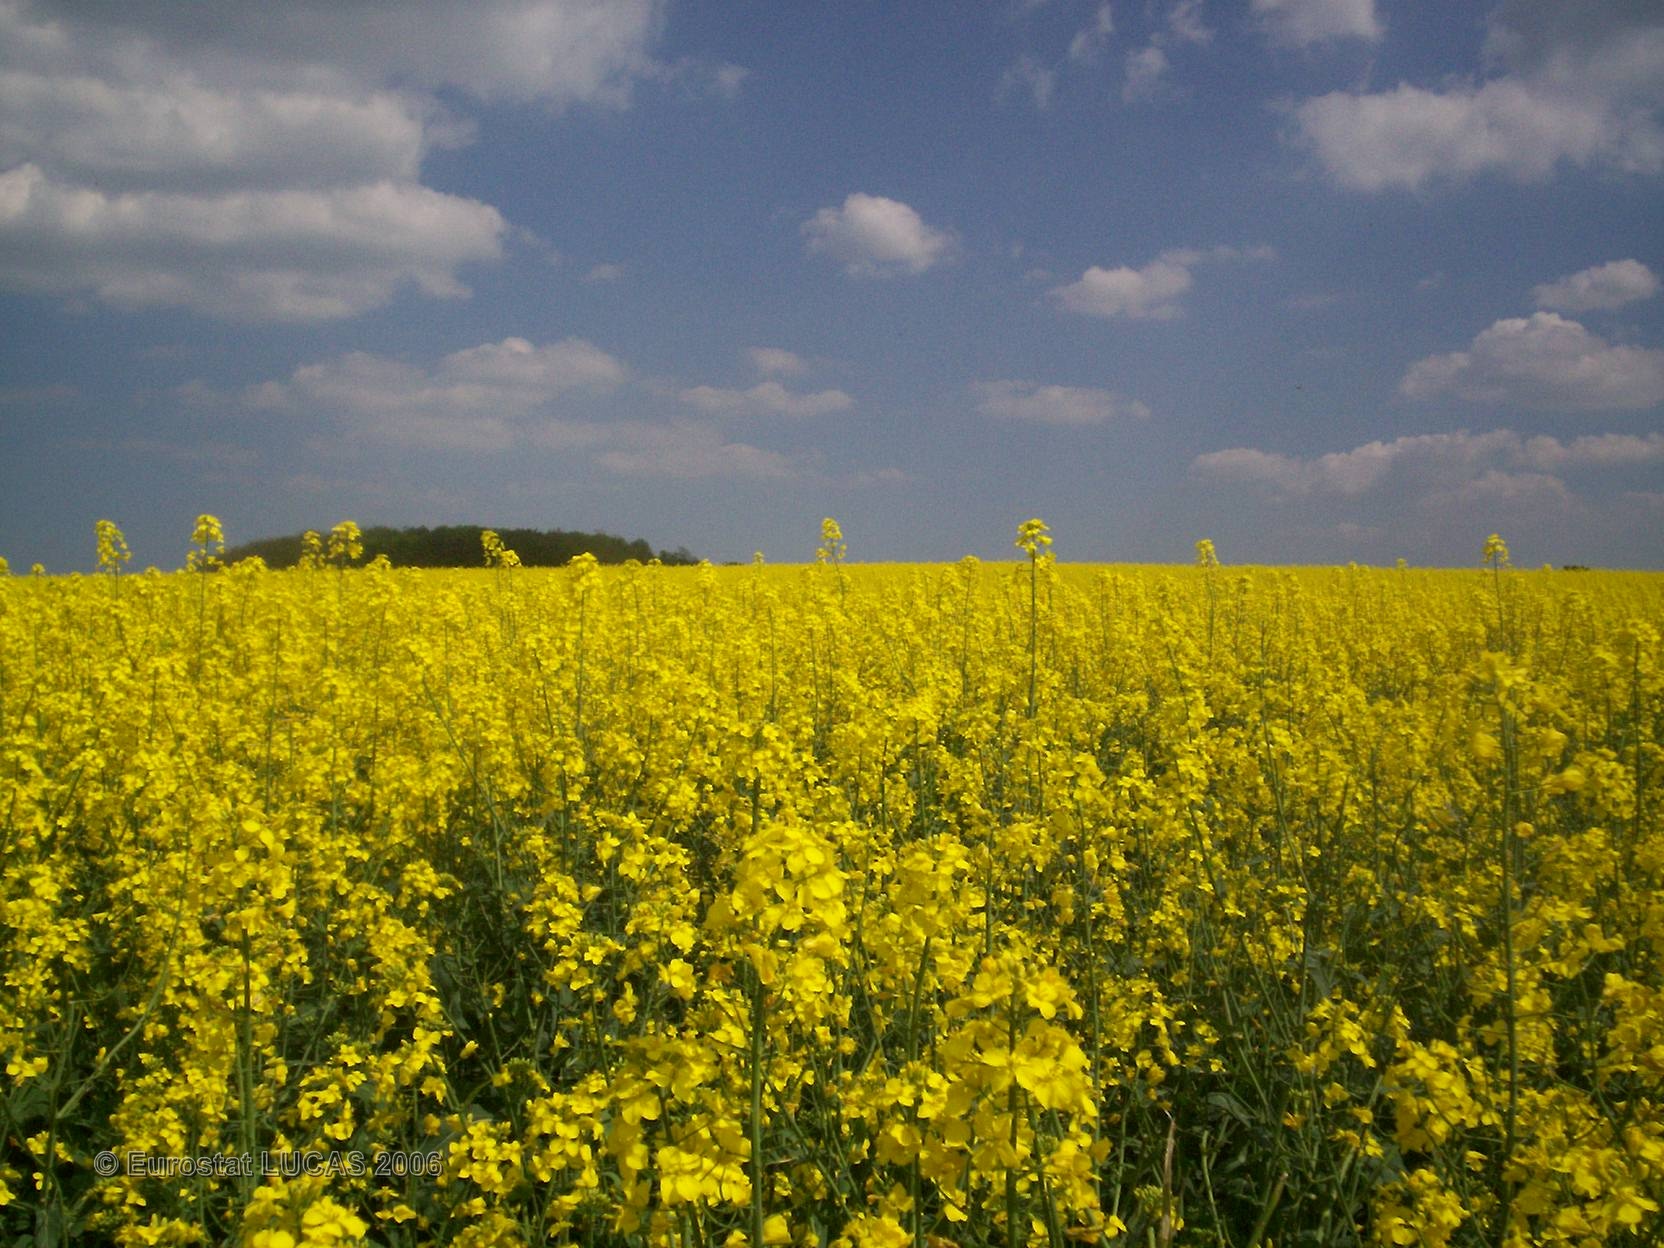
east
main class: Cropland
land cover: Rape and turnip rape
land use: Agriculture (excluding fallow land and kitchen gardens)
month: May
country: FR
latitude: 48.3572
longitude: 4.8834
